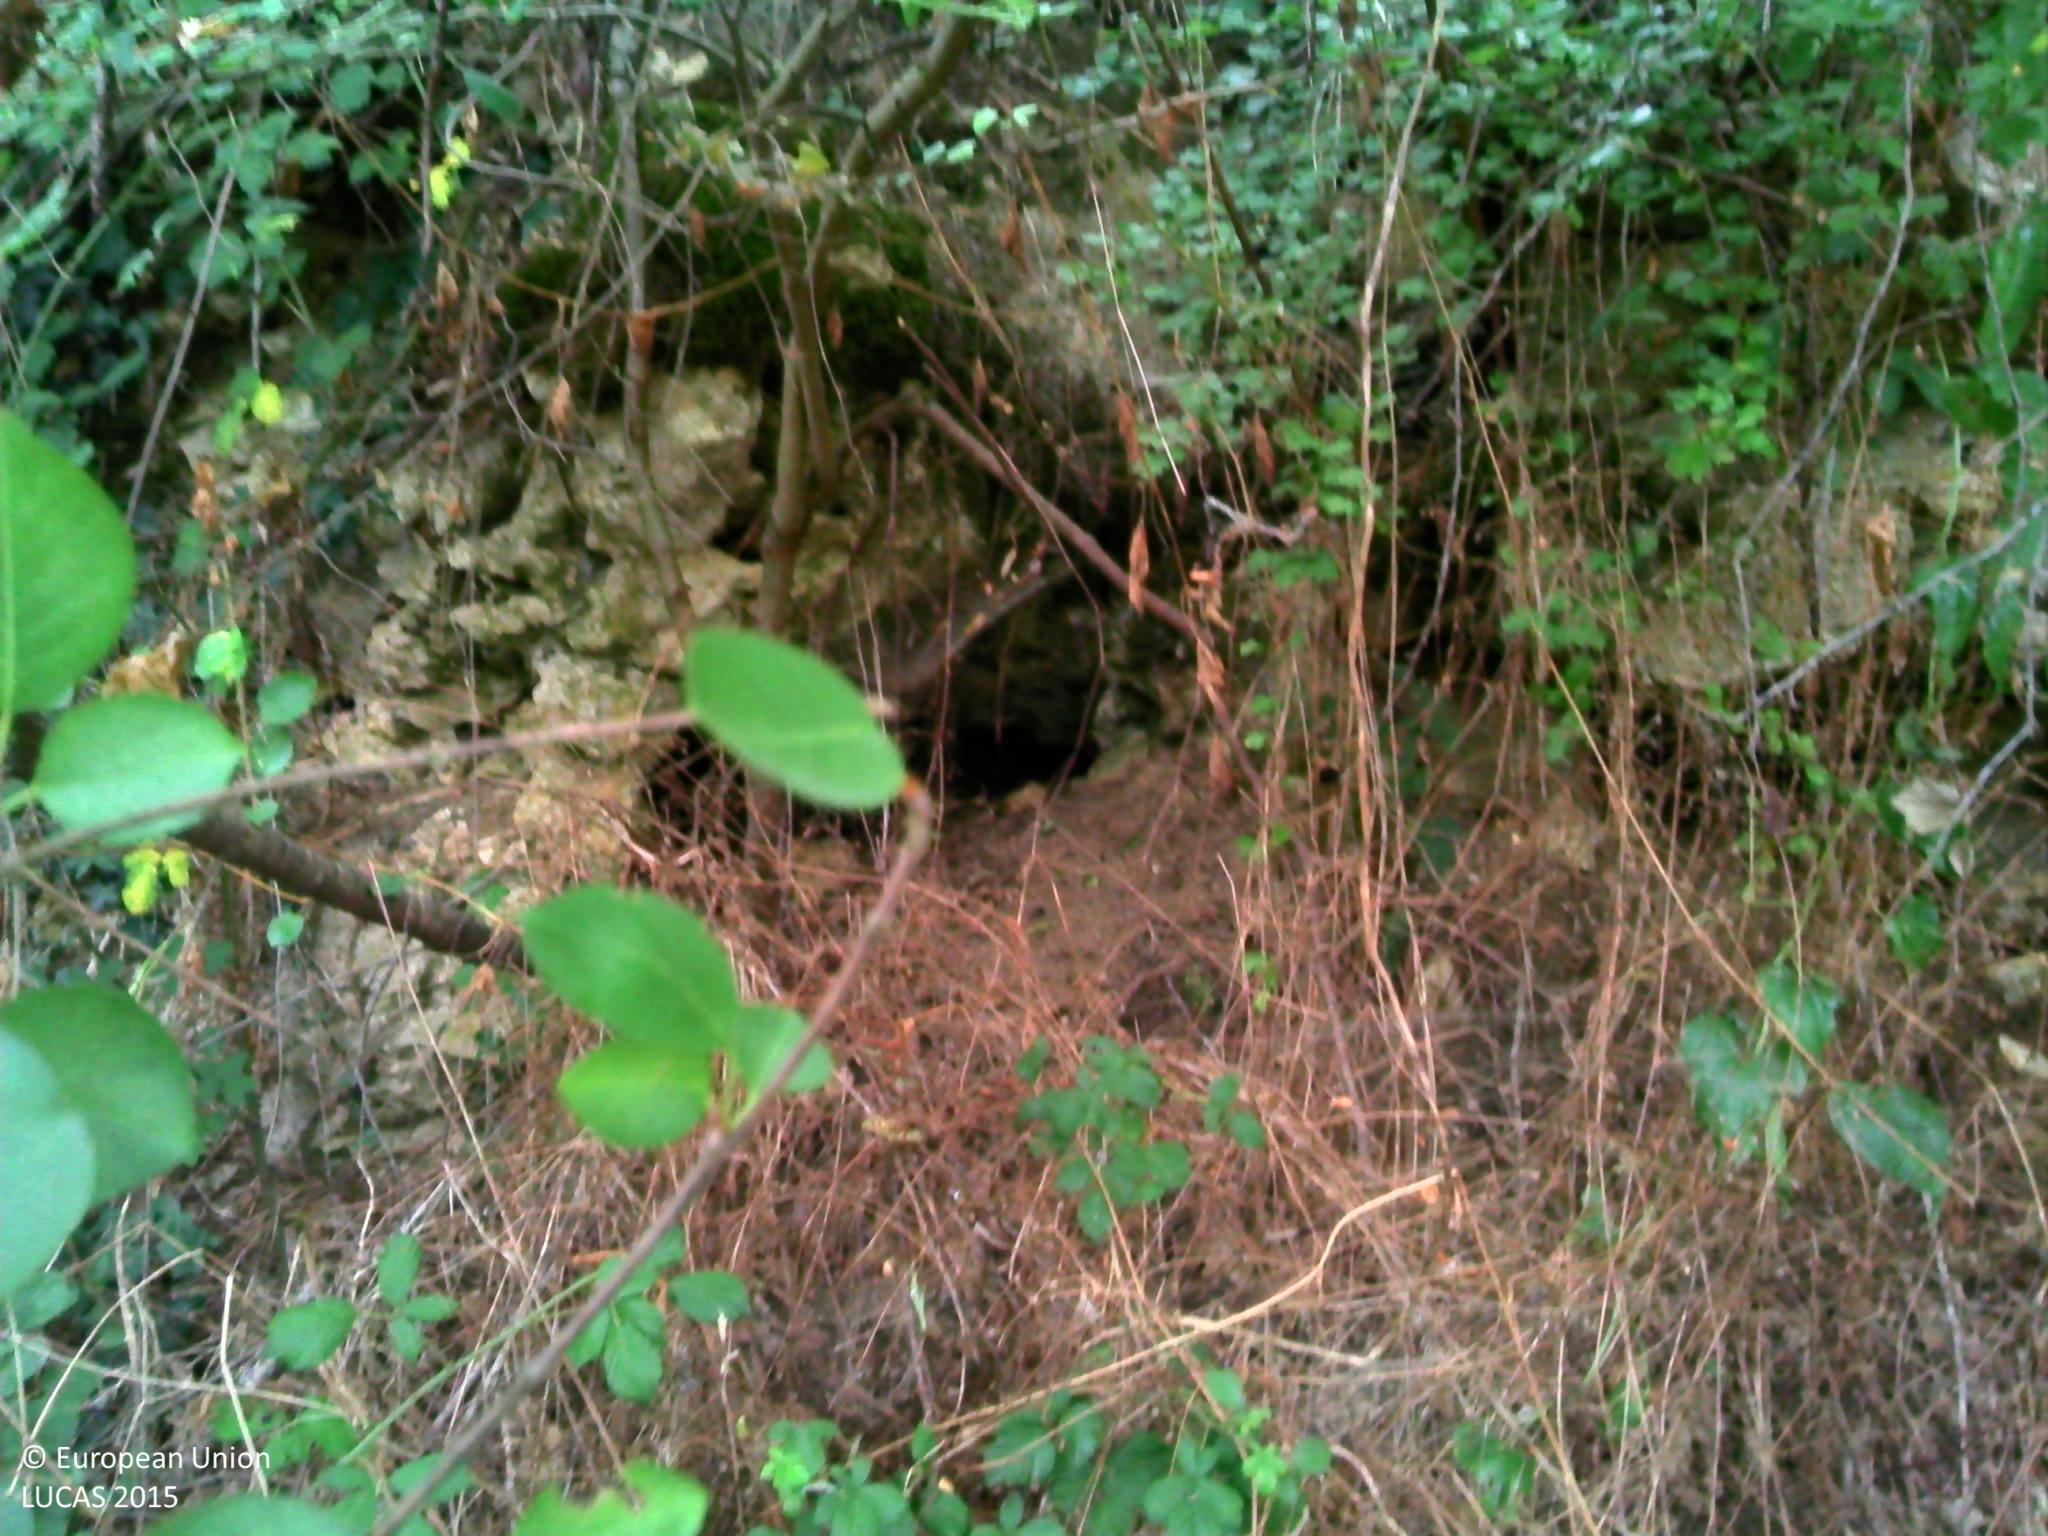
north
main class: Woodland
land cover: Broadleaved woodland
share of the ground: > 75 %
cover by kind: broadleaved forest trees 95 %, shrubs 5 %
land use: Agriculture (excluding fallow land and kitchen gardens)
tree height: > 5 m
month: July
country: FR
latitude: 44.2889
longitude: 0.8348
